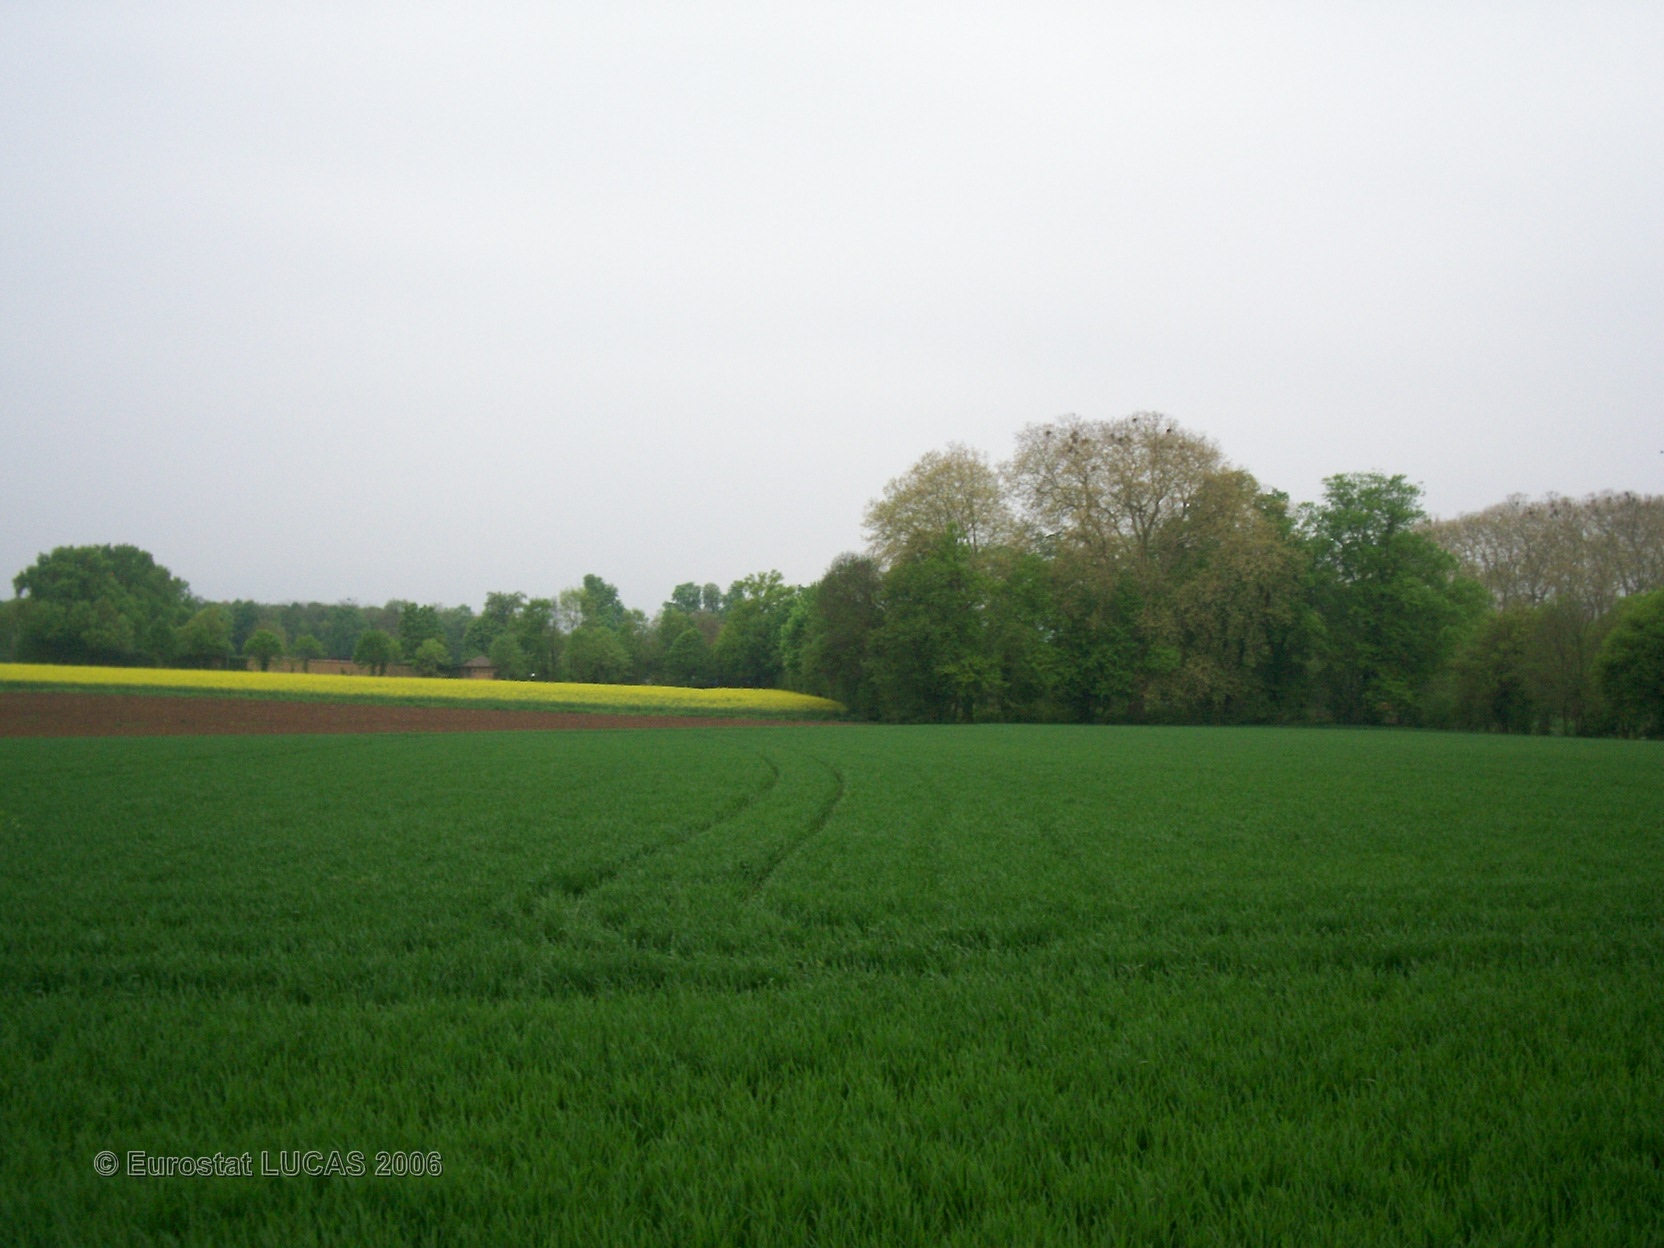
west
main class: Cropland
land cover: Maize
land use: Agriculture (excluding fallow land and kitchen gardens)
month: June
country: FR
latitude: 46.0428
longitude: 4.7692
